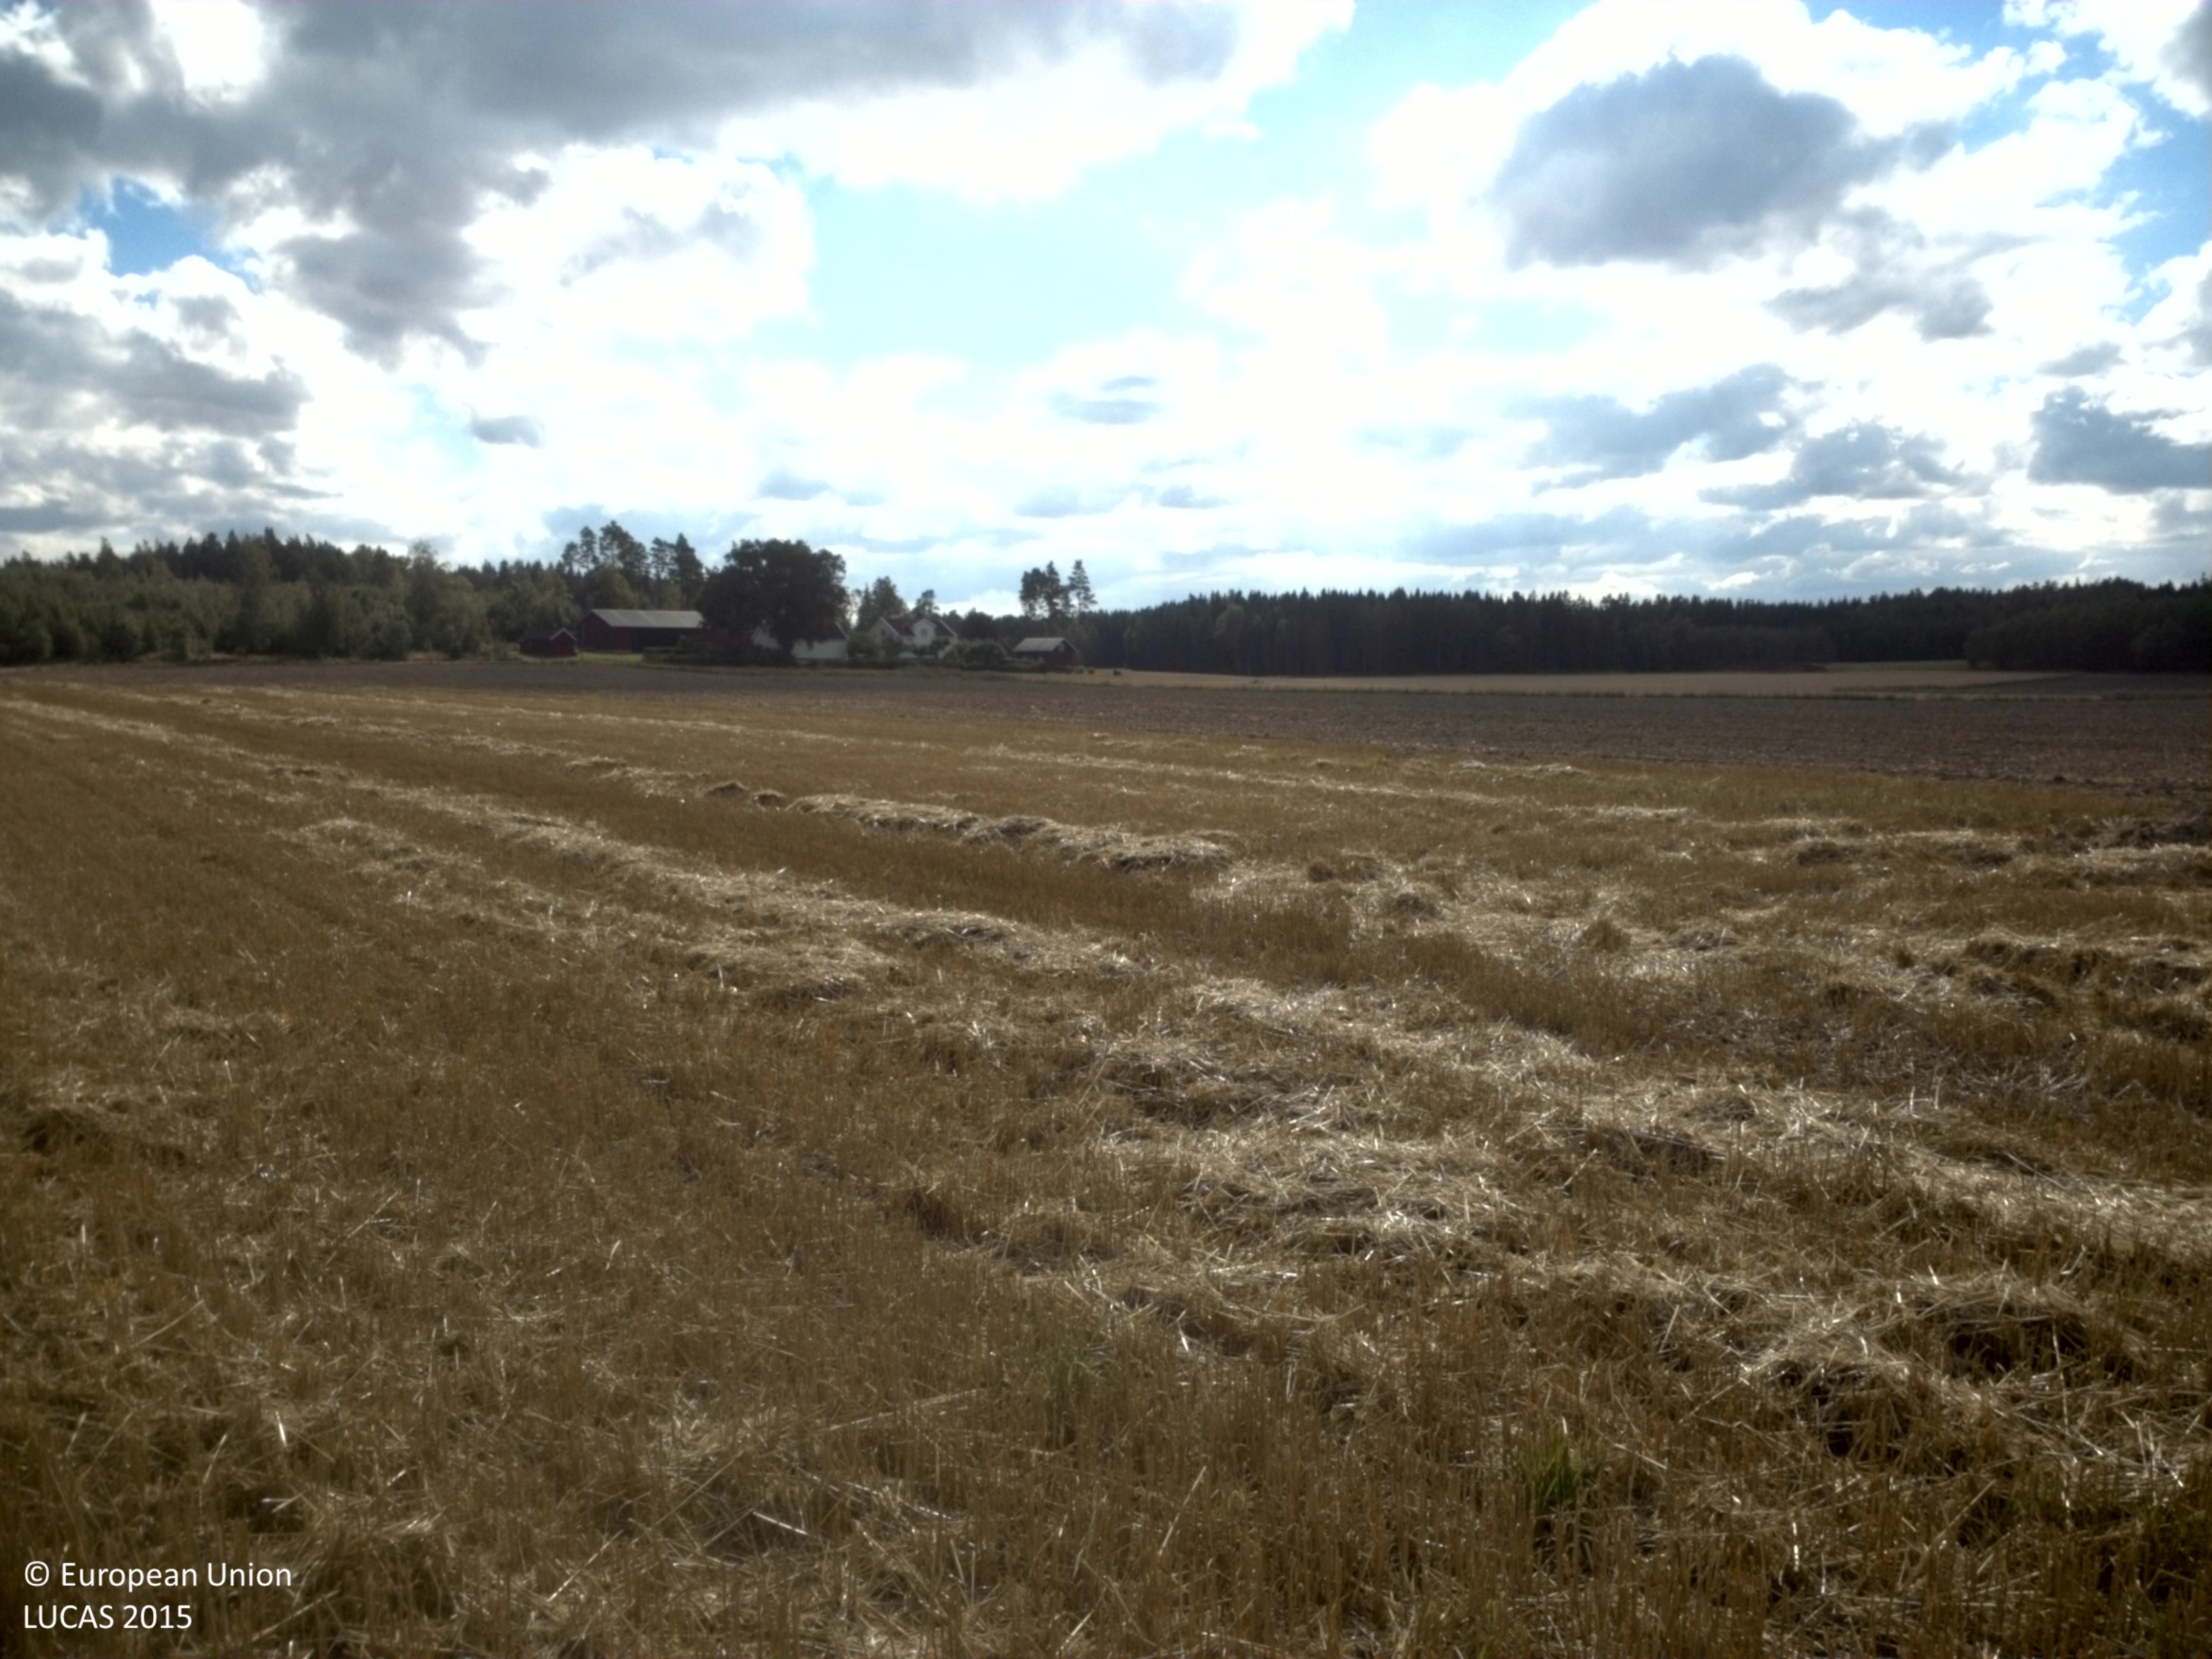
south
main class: Cropland
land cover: Common wheat
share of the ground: 50 - 75 %
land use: Agriculture (excluding fallow land and kitchen gardens)
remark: Harvested field
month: September
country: SE
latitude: 58.3851
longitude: 12.9535
